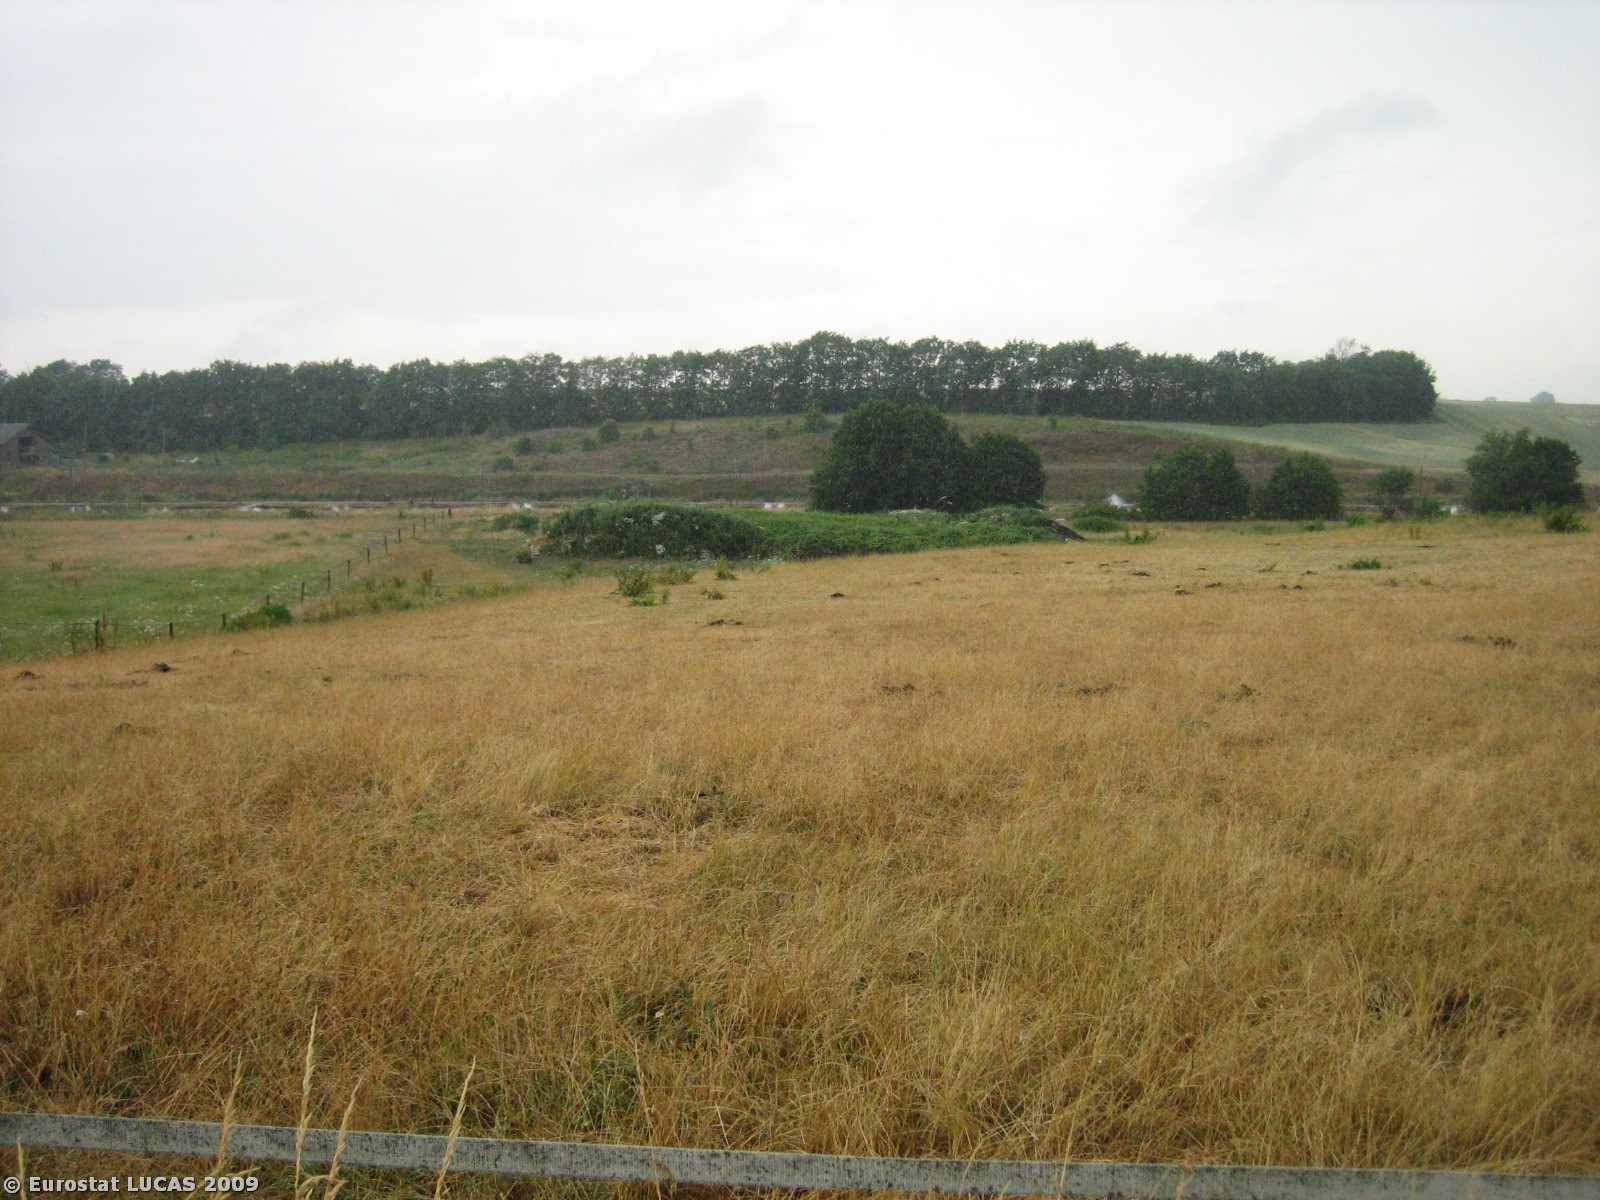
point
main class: Shrubland
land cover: Shrubland without tree cover
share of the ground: > 75 %
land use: Unused
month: July
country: DK
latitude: 55.4997
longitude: 8.8771
